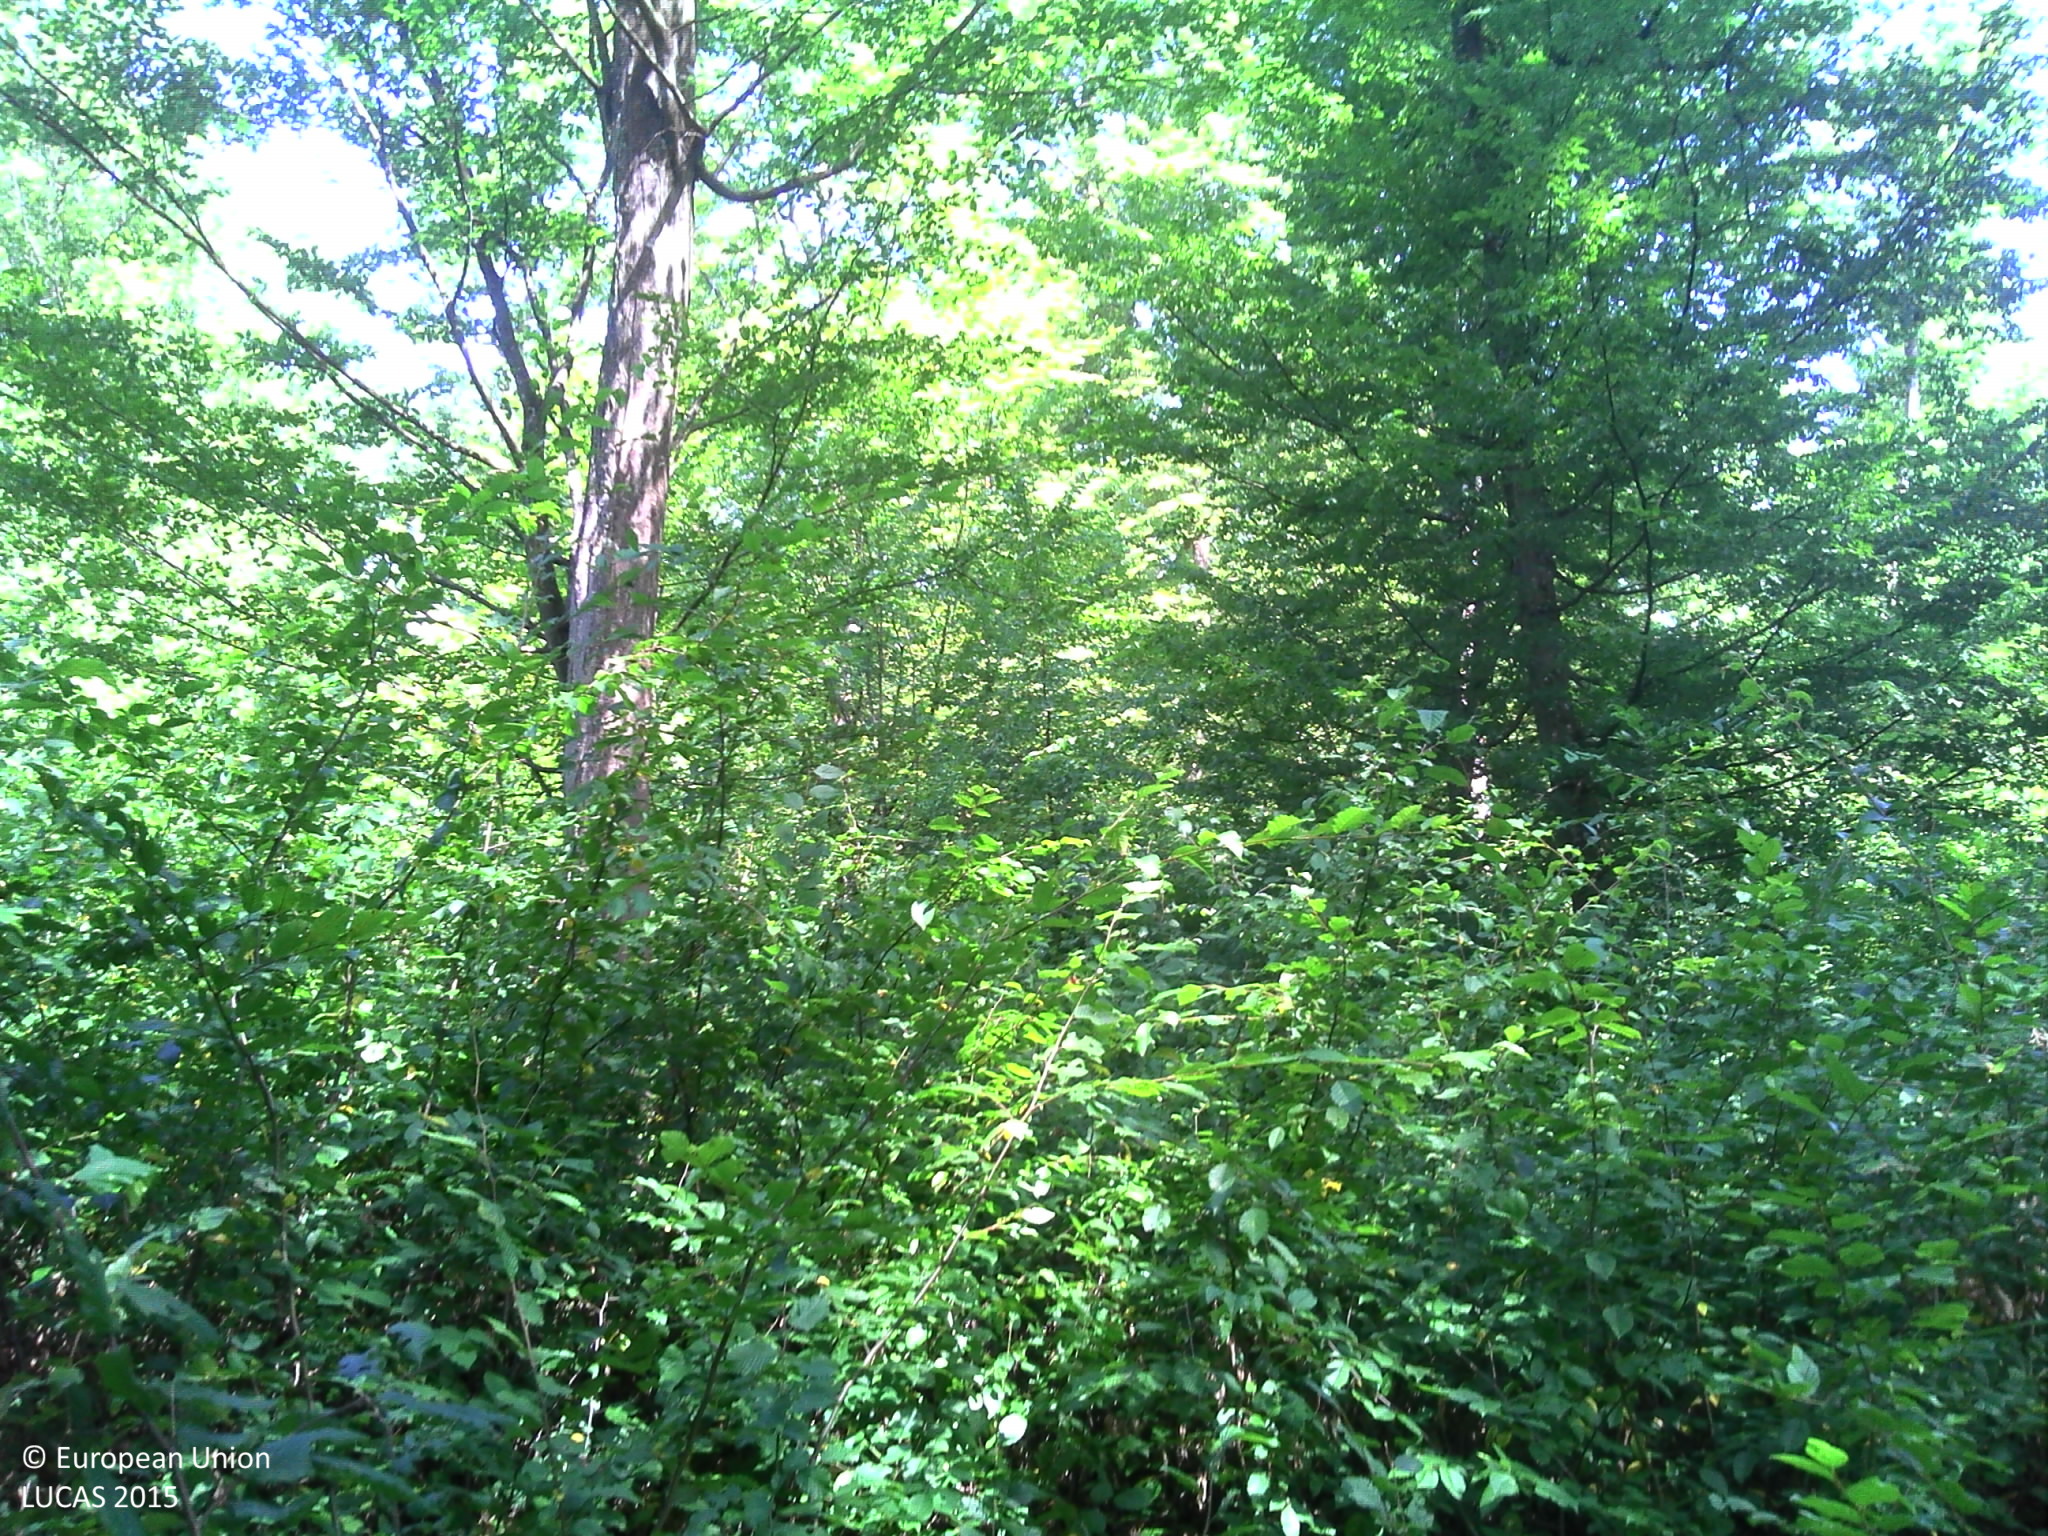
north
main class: Woodland
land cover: Broadleaved woodland
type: mesophytic deciduous forest
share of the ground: > 75 %
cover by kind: broadleaved forest trees 85 %, herbaceous plants 15 %
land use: Forestry
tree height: > 5 m
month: July
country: FR
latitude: 48.8661
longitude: 7.7241
